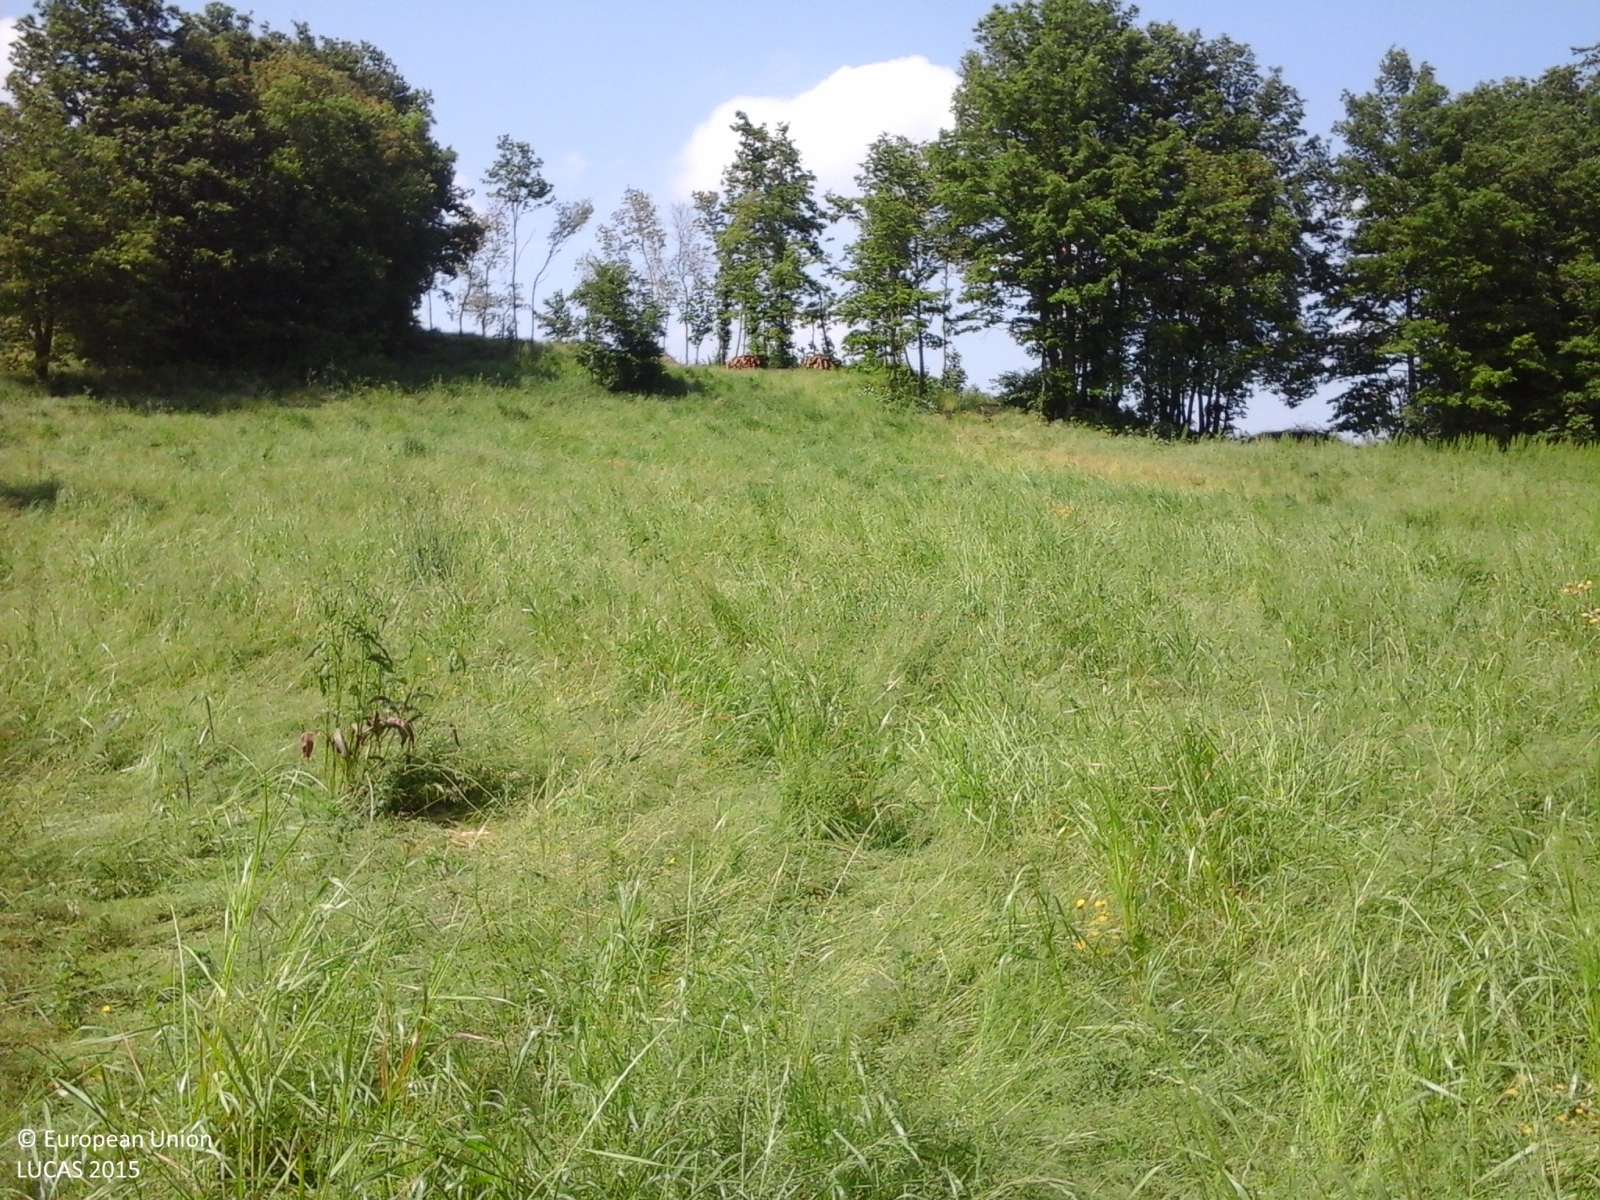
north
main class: Grassland
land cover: Spontaneously vegetated surfaces
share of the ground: > 75 %
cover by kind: herbaceous plants 100 %
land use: Agriculture (excluding fallow land and kitchen gardens)
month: May
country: IT
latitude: 44.3836
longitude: 10.7890
